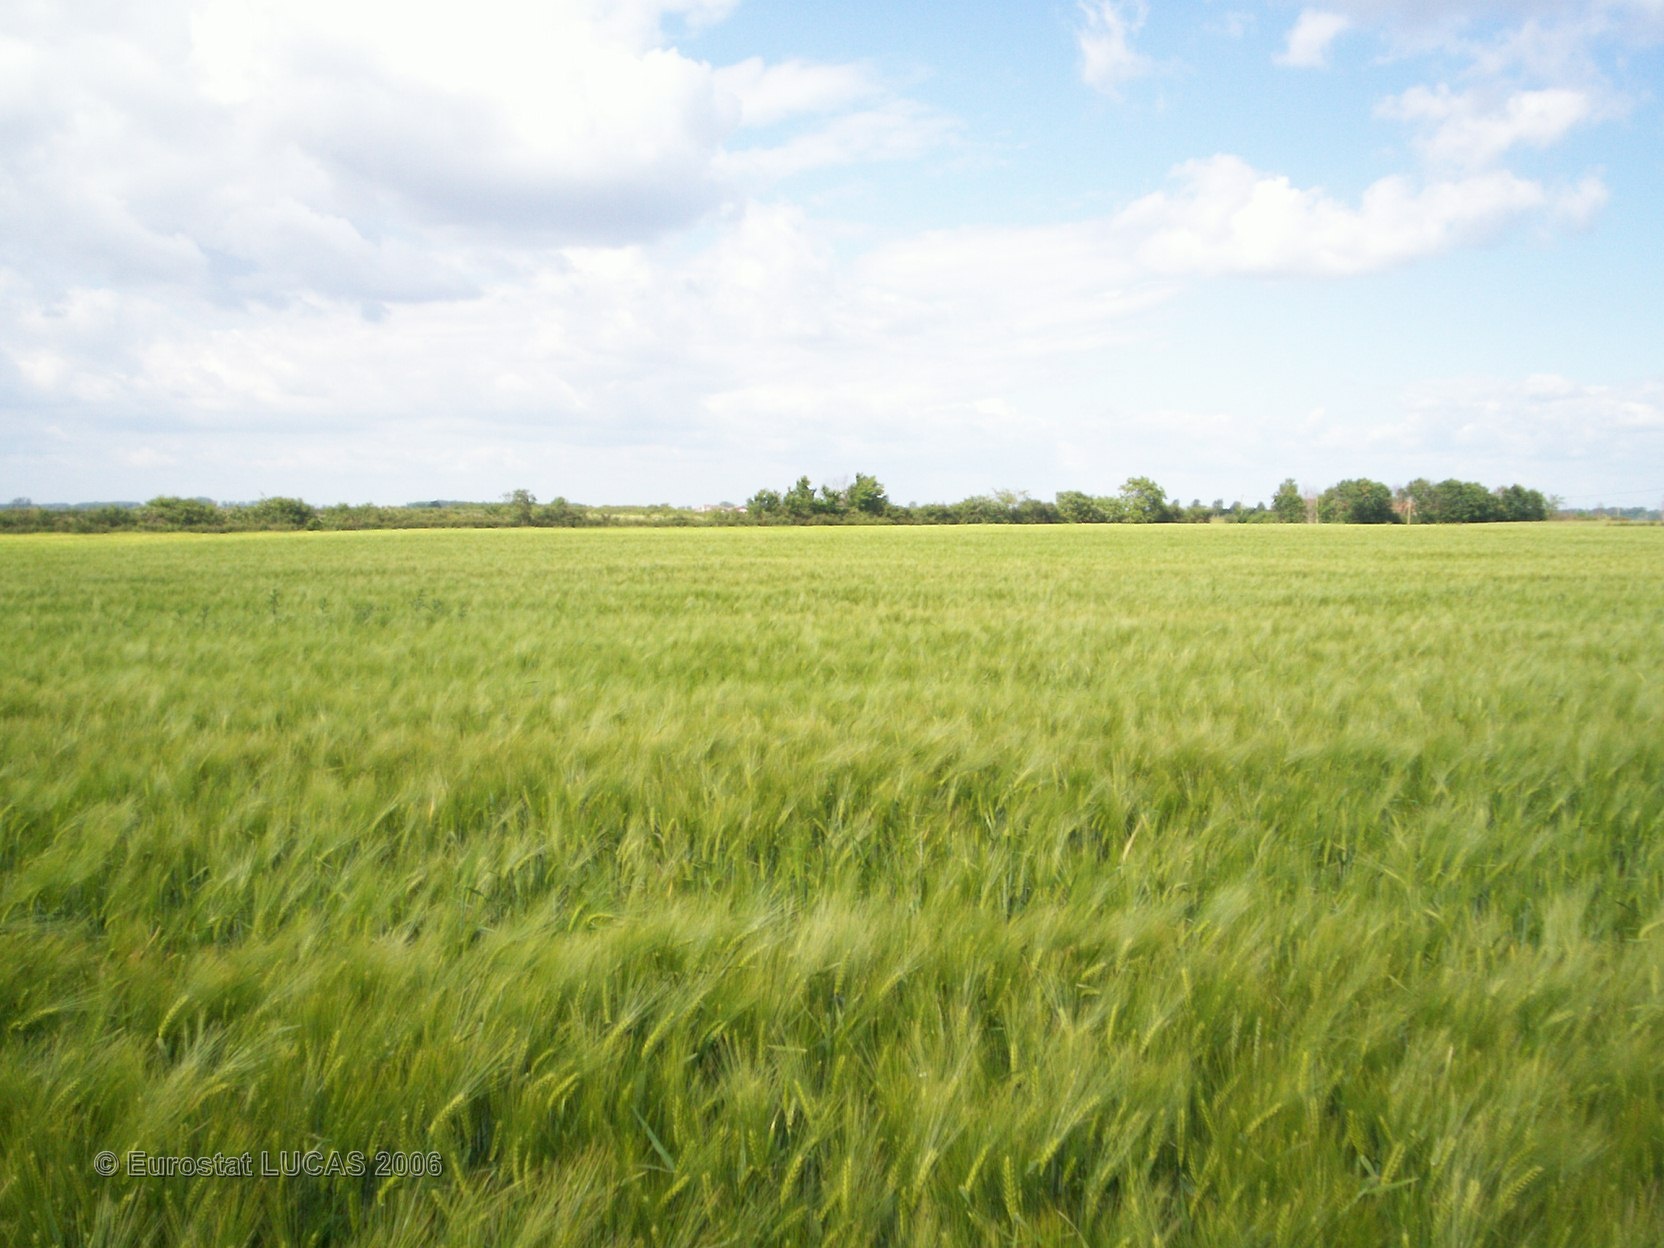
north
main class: Cropland
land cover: Barley
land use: Agriculture (excluding fallow land and kitchen gardens)
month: June
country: FR
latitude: 46.1904
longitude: 3.2224
